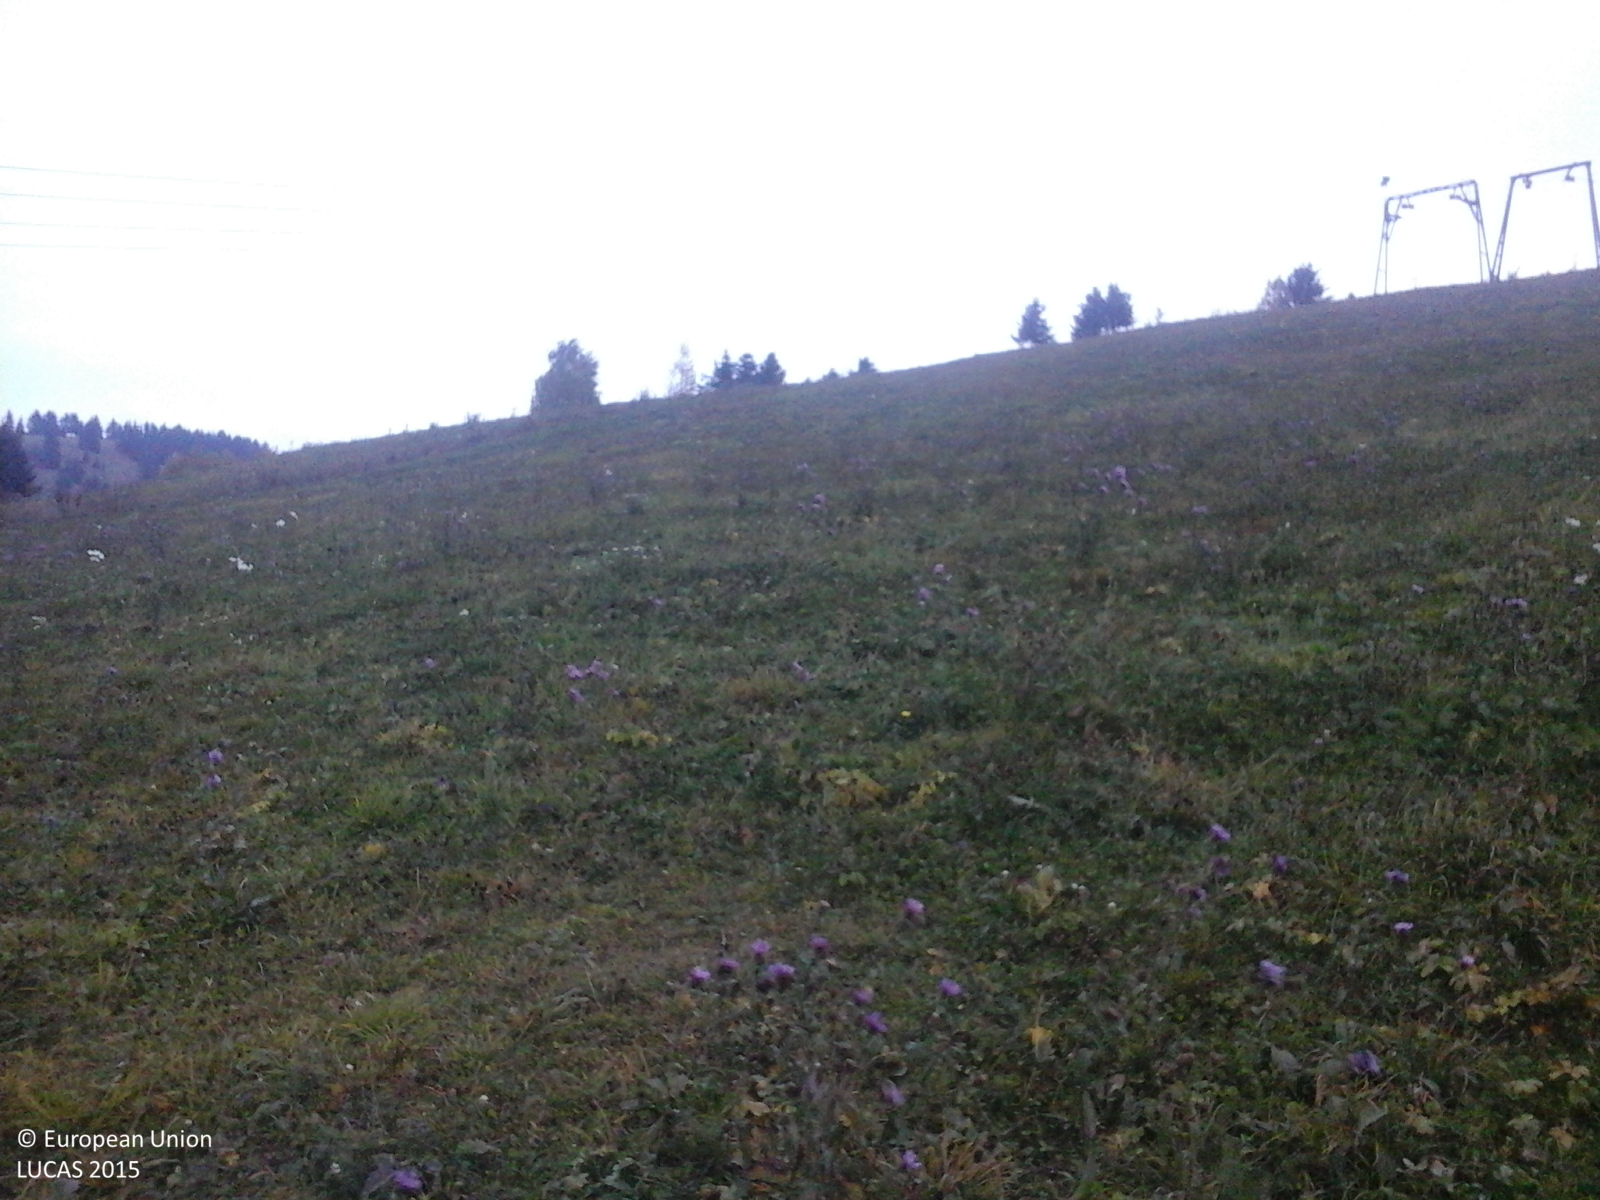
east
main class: Grassland
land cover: Grassland without tree/shrub cover
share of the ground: > 75 %
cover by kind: herbaceous plants 100 %
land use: Agriculture (excluding fallow land and kitchen gardens)
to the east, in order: Grassland without tree/shrub cover; Electric lines; Grassland without tree/shrub cover; Fences; Abandoned hedges; Ditches and canals; Single bushes/trees; Fences; Grassland without tree/shrub cover
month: October
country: RO
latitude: 46.5193
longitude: 25.9575
